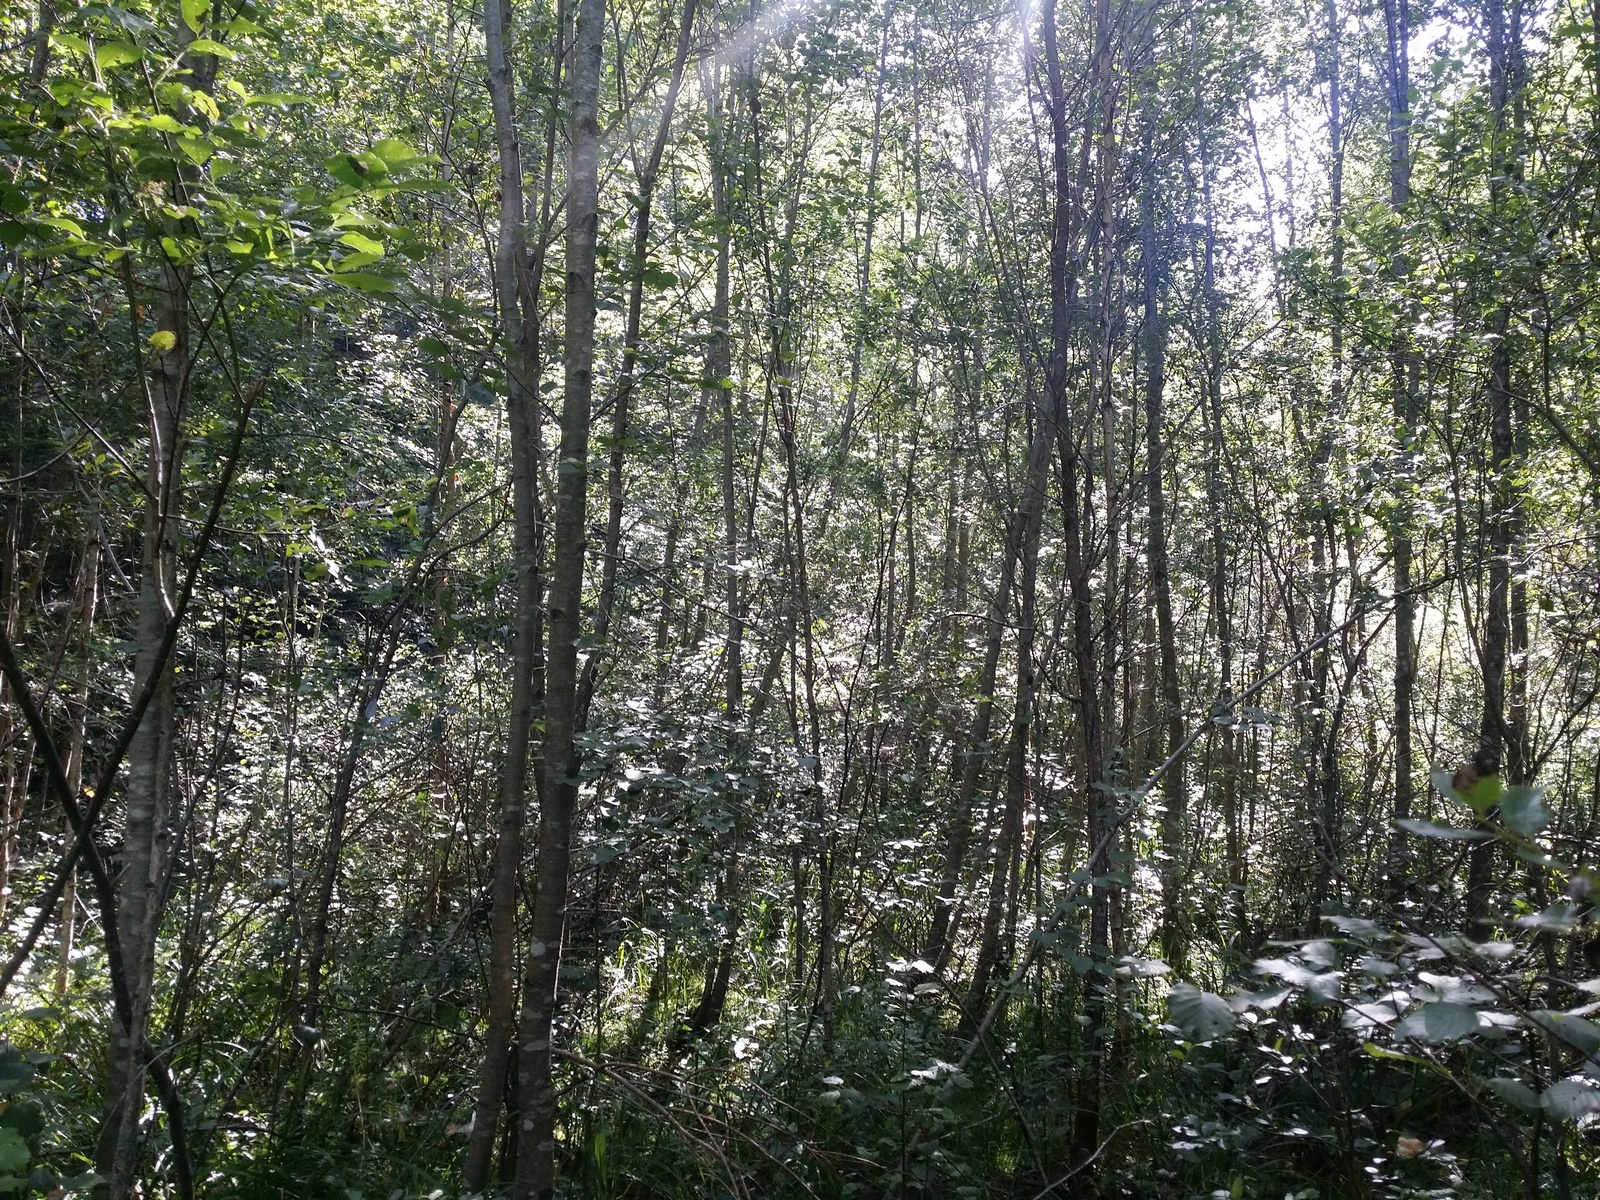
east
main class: Woodland
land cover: Broadleaved woodland
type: non-riverine alder, birch or aspen forest
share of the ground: > 75 %
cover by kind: broadleaved forest trees 85 %, herbaceous plants 15 %
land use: Semi-natural and natural areas not in use
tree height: < 5 m
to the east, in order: Broadleaved woodland; Spruce dominated coniferous woodland; Broadleaved woodland; Other mixed woodland; Shrubland with sparse tree cover; Broadleaved woodland; Spruce dominated mixed woodland
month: August
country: LV
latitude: 57.5065
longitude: 26.8947
